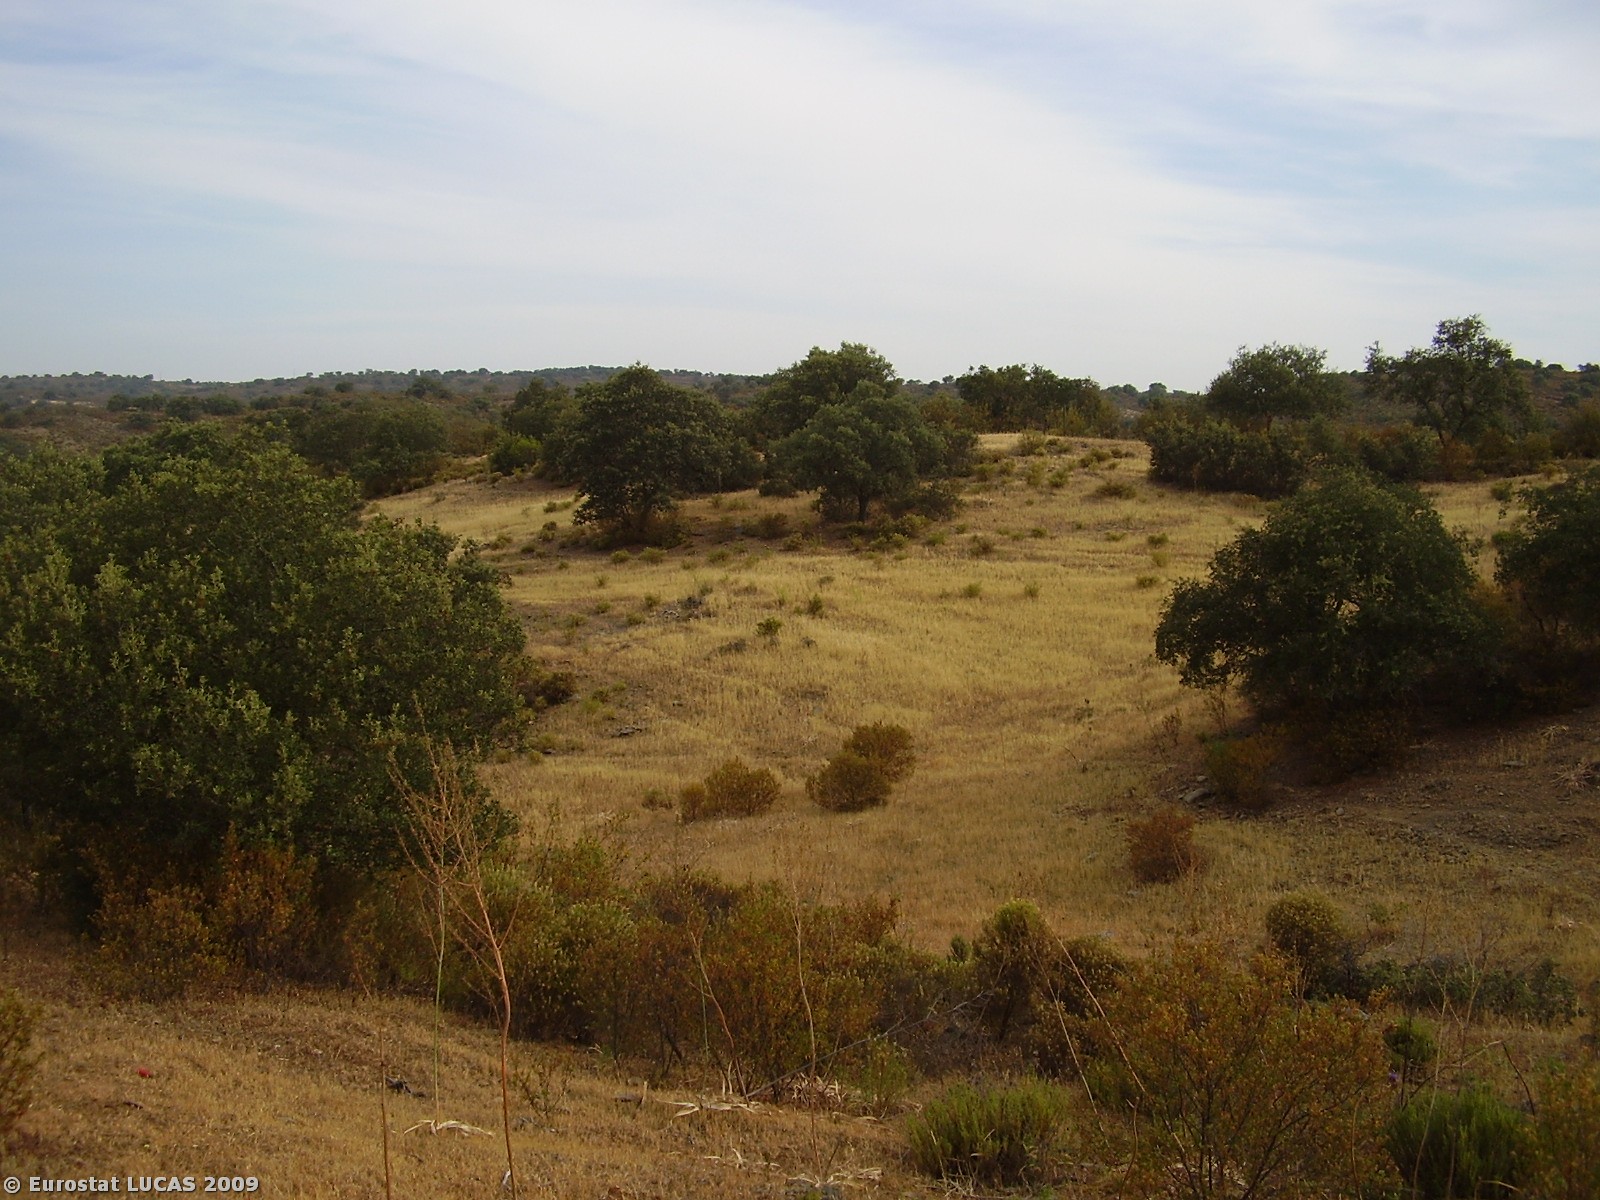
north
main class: Woodland
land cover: Broadleaved woodland
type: broadleaved evergreen forest
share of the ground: 50 - 75 %
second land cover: Spontaneously vegetated surfaces
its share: 50 - 75 %
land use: Forestry
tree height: > 5 m
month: May
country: PT
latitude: 37.5942
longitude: -7.5791
